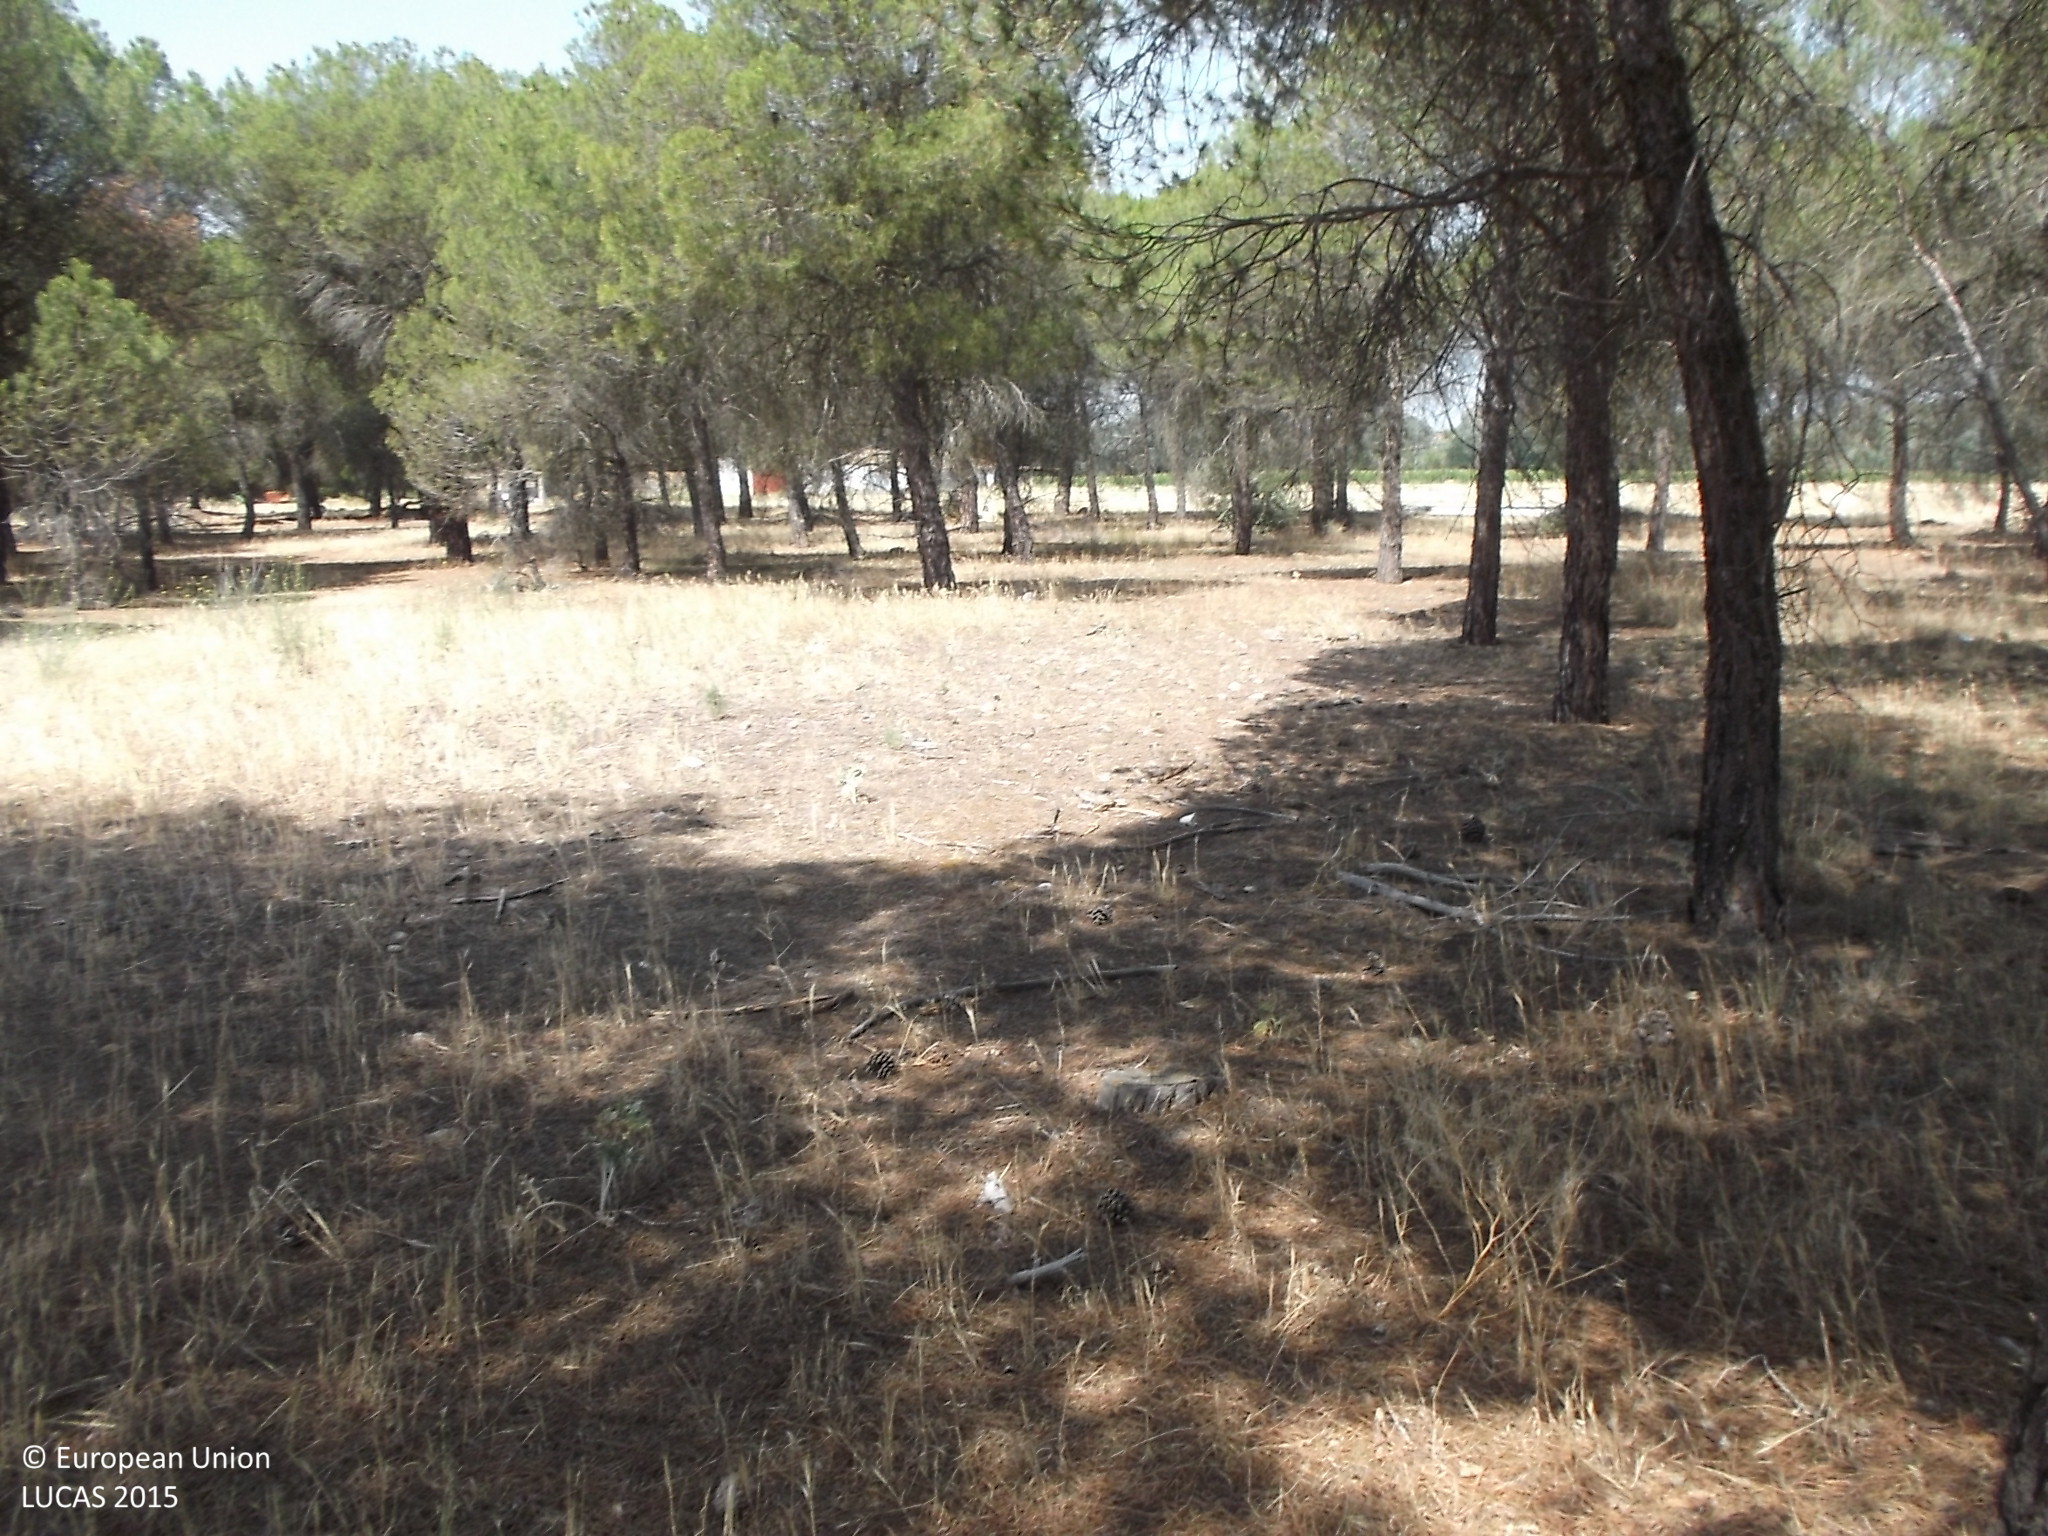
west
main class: Woodland
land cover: Pine dominated coniferous woodland
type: coniferous forest of the mediterranean region
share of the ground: > 75 %
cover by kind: coniferous forest trees 90 %, herbaceous plants 10 %
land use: Forestry
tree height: < 5 m
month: July
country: ES
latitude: 41.4691
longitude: -5.3935
